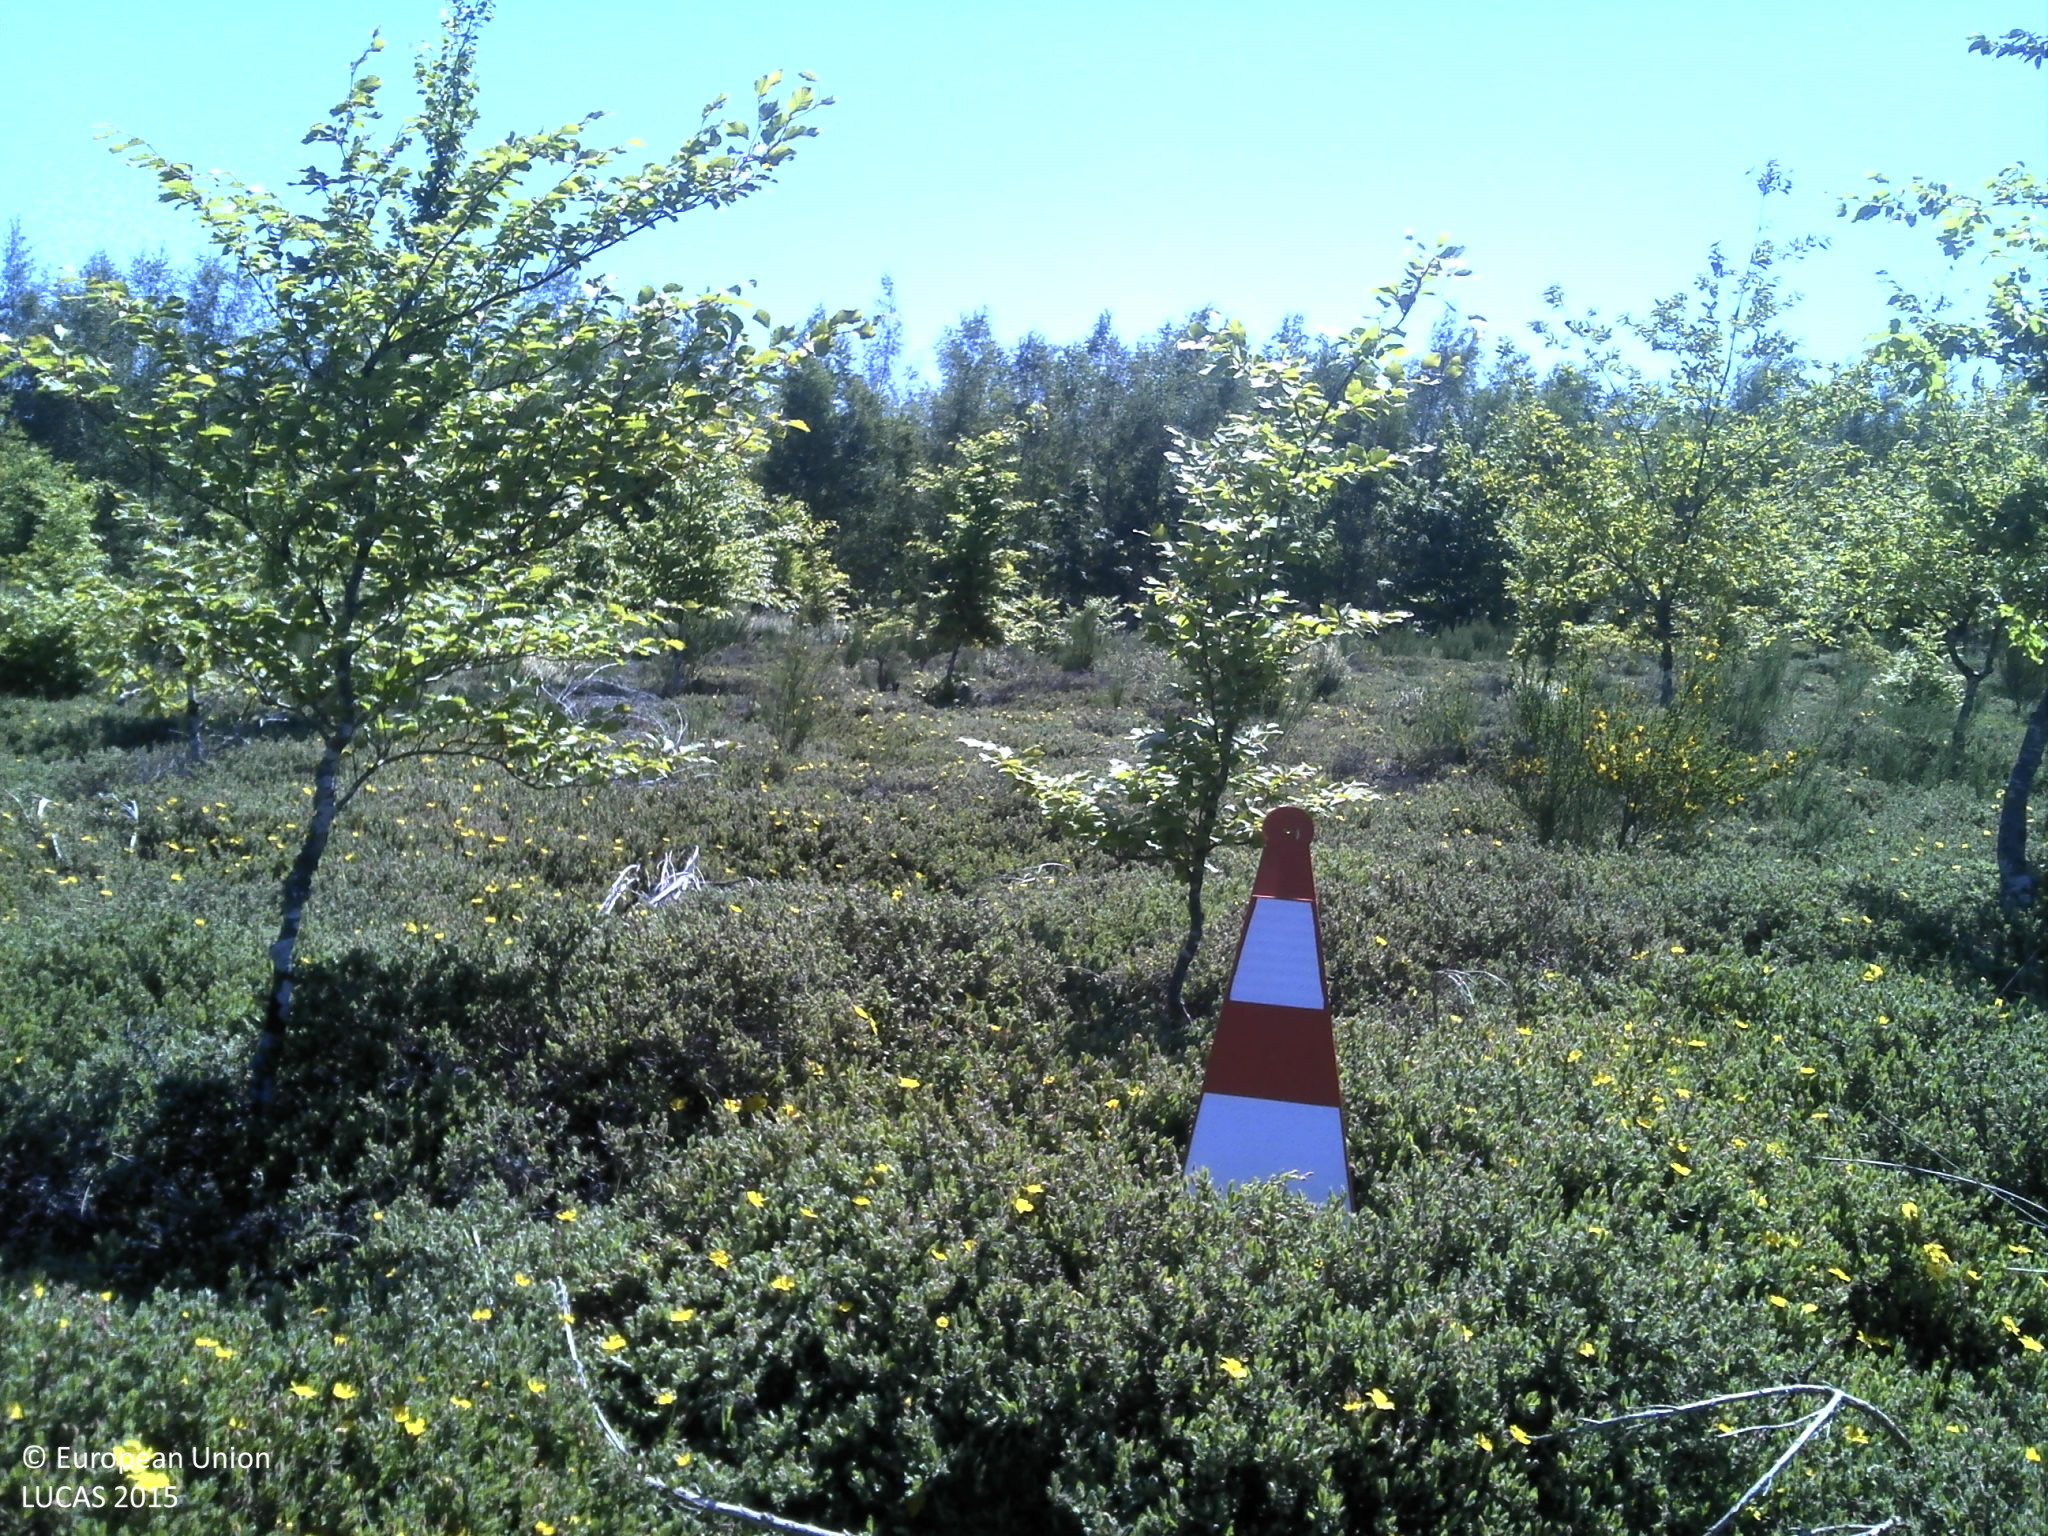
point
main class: Woodland
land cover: Broadleaved woodland
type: mesophytic deciduous forest
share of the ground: 25 - 50 %
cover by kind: broadleaved forest trees 45 %, shrubs 25 %, herbaceous plants 25 %
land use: Forestry
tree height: > 5 m
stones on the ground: 10 - 25 %
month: May
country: PT
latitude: 40.5212
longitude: -7.4252
